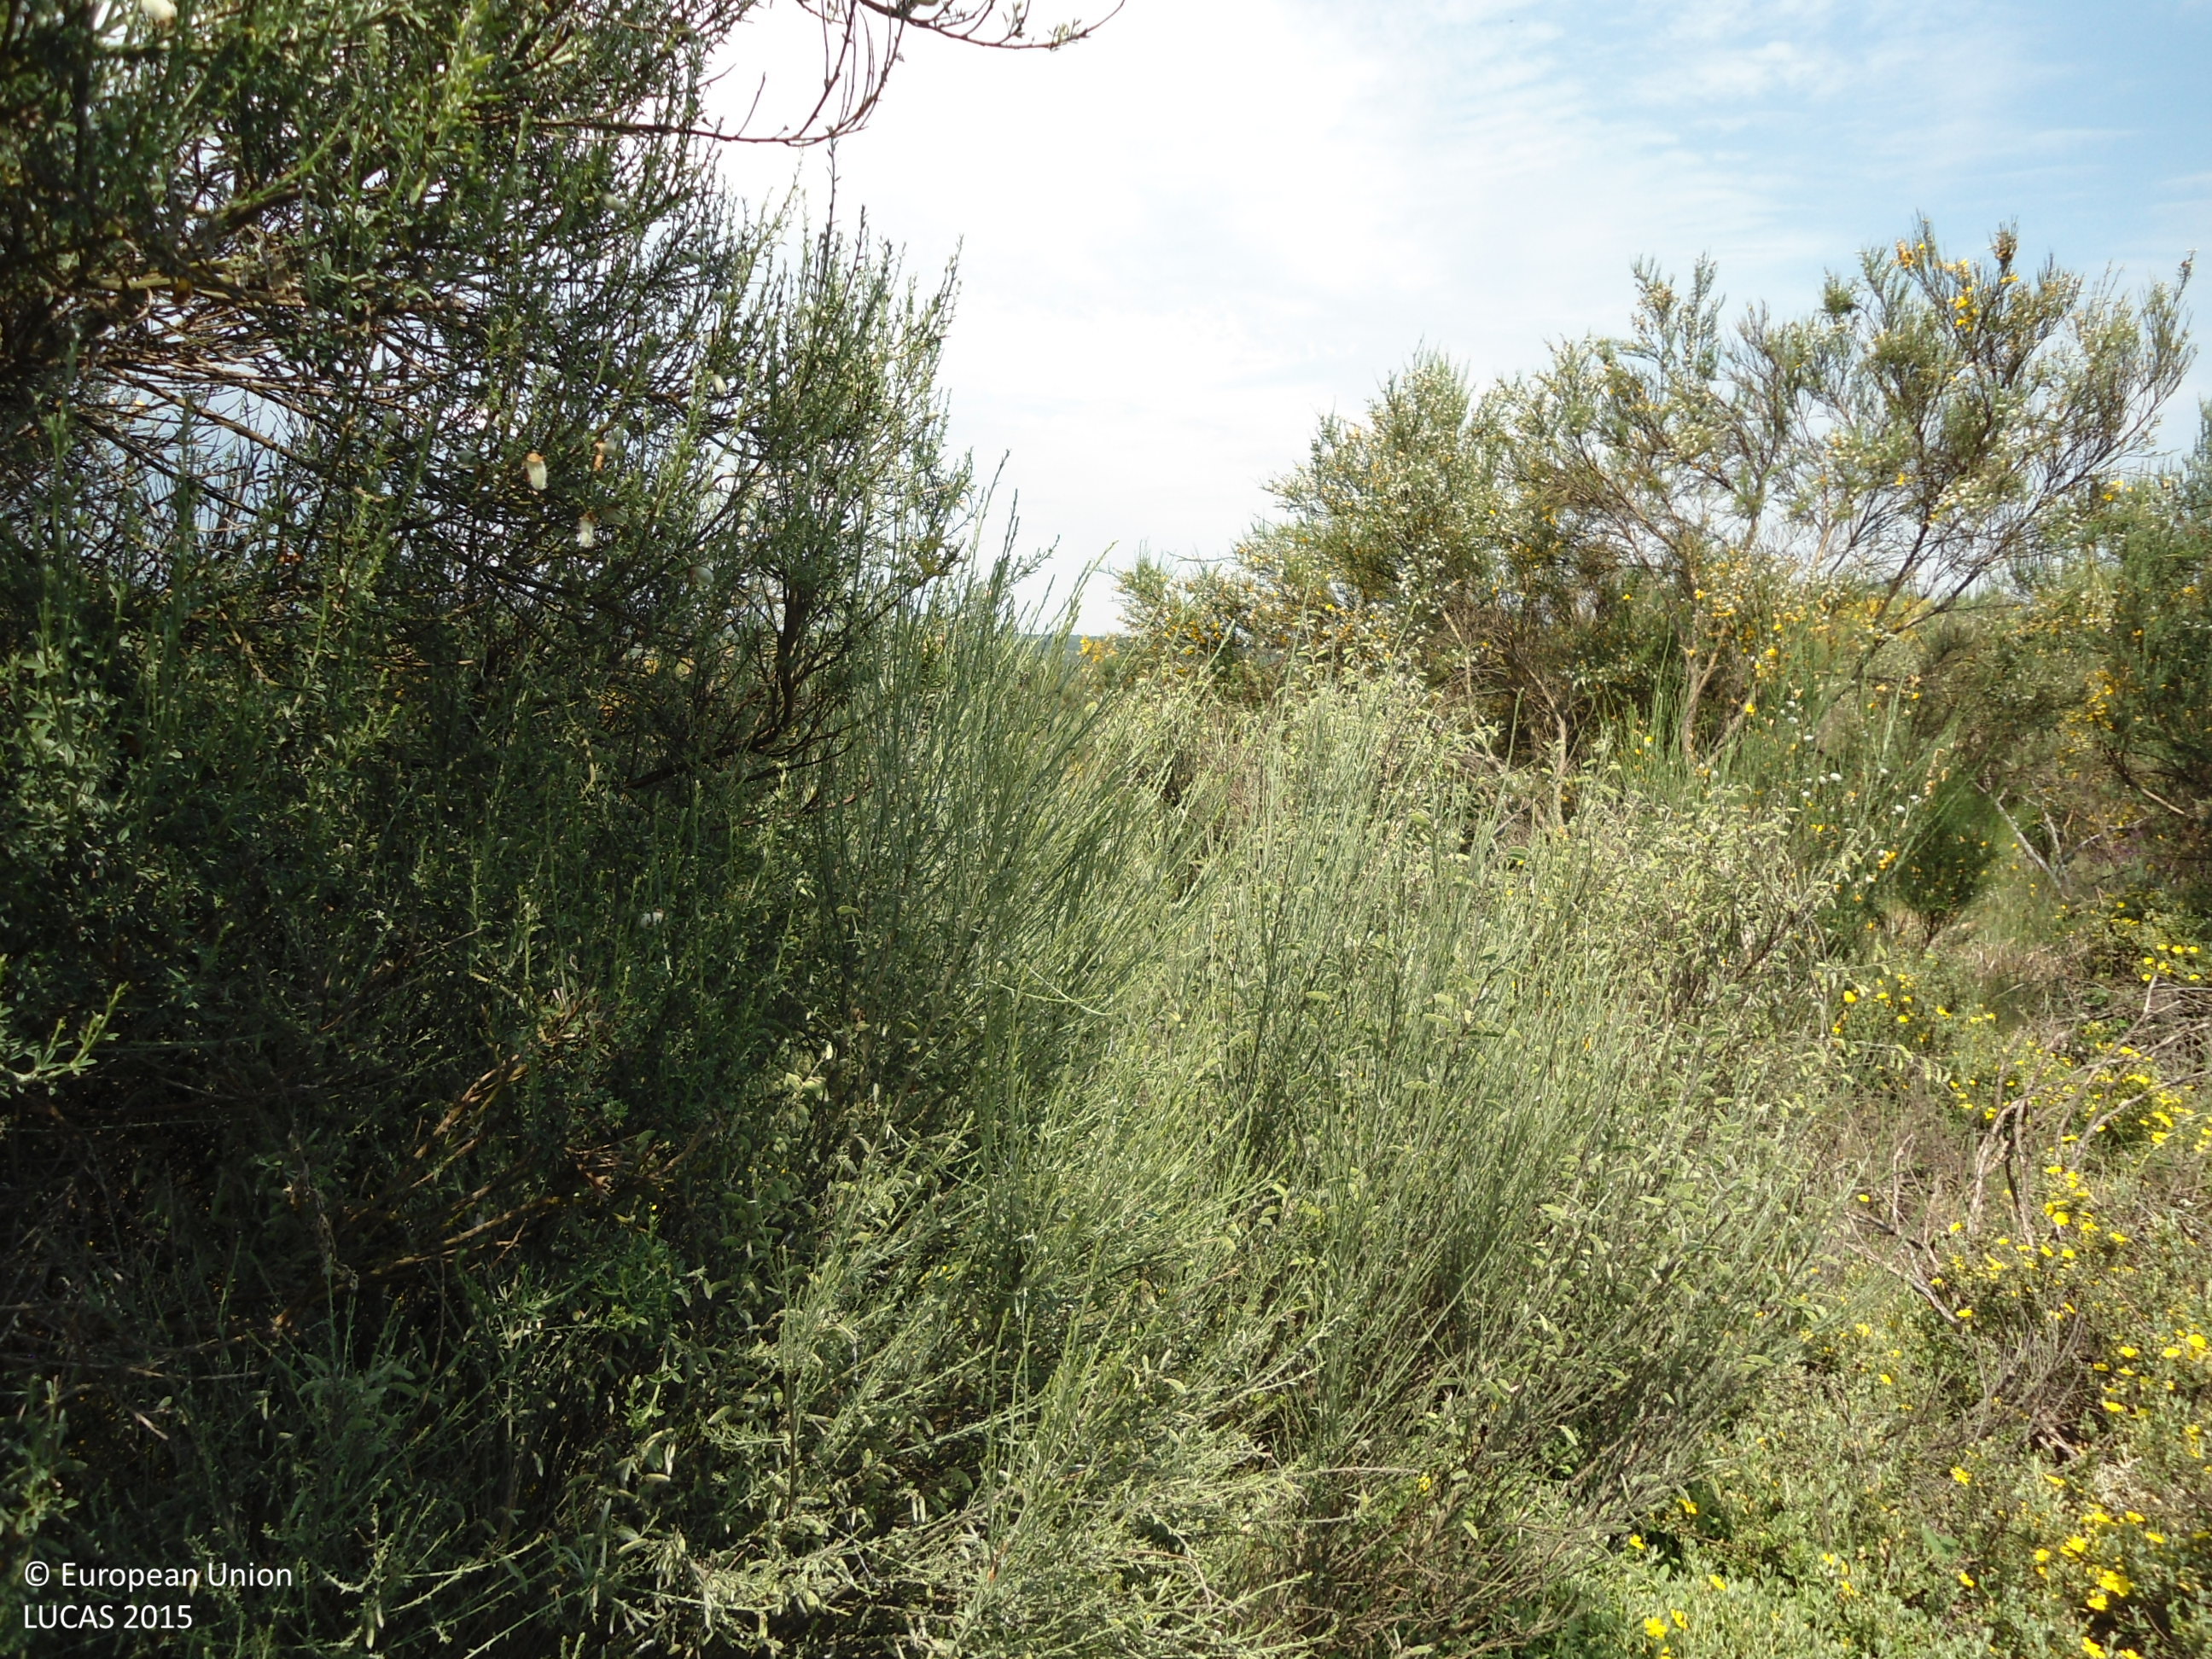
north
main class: Shrubland
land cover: Shrubland without tree cover
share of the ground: > 75 %
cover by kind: shrubs 80 %, herbaceous plants 20 %
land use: Semi-natural and natural areas not in use
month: June
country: ES
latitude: 41.9886
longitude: -6.3905
